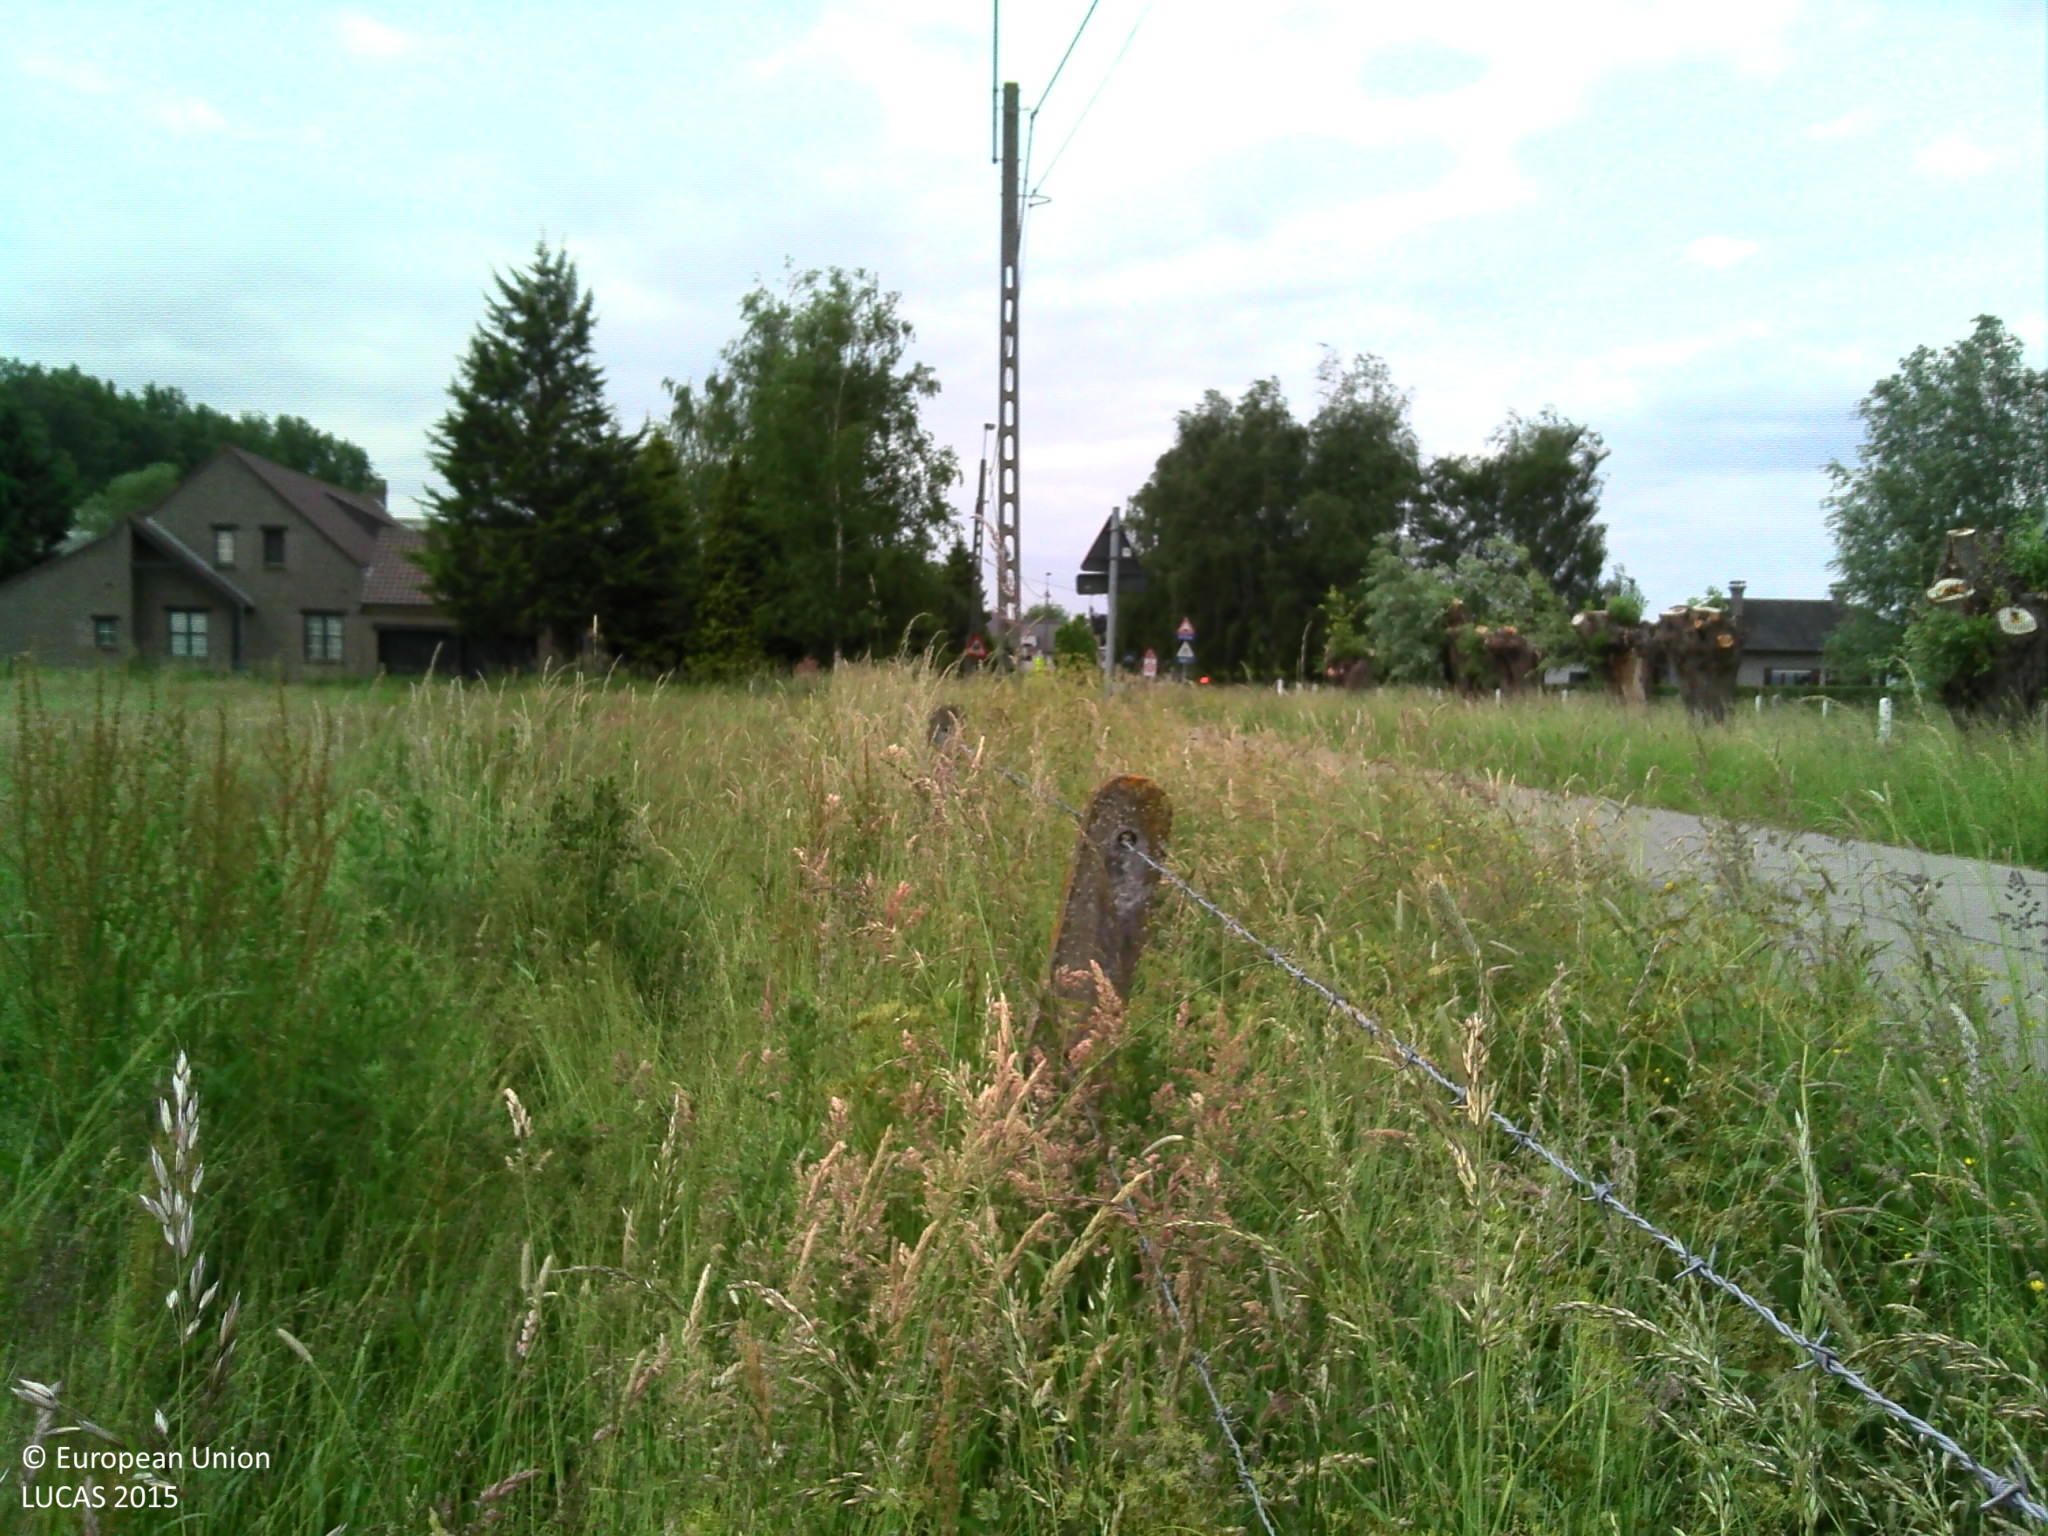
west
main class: Grassland
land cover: Grassland without tree/shrub cover
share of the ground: > 75 %
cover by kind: herbaceous plants 100 %
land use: Agriculture (excluding fallow land and kitchen gardens)
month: June
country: BE
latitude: 51.0011
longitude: 4.0234
